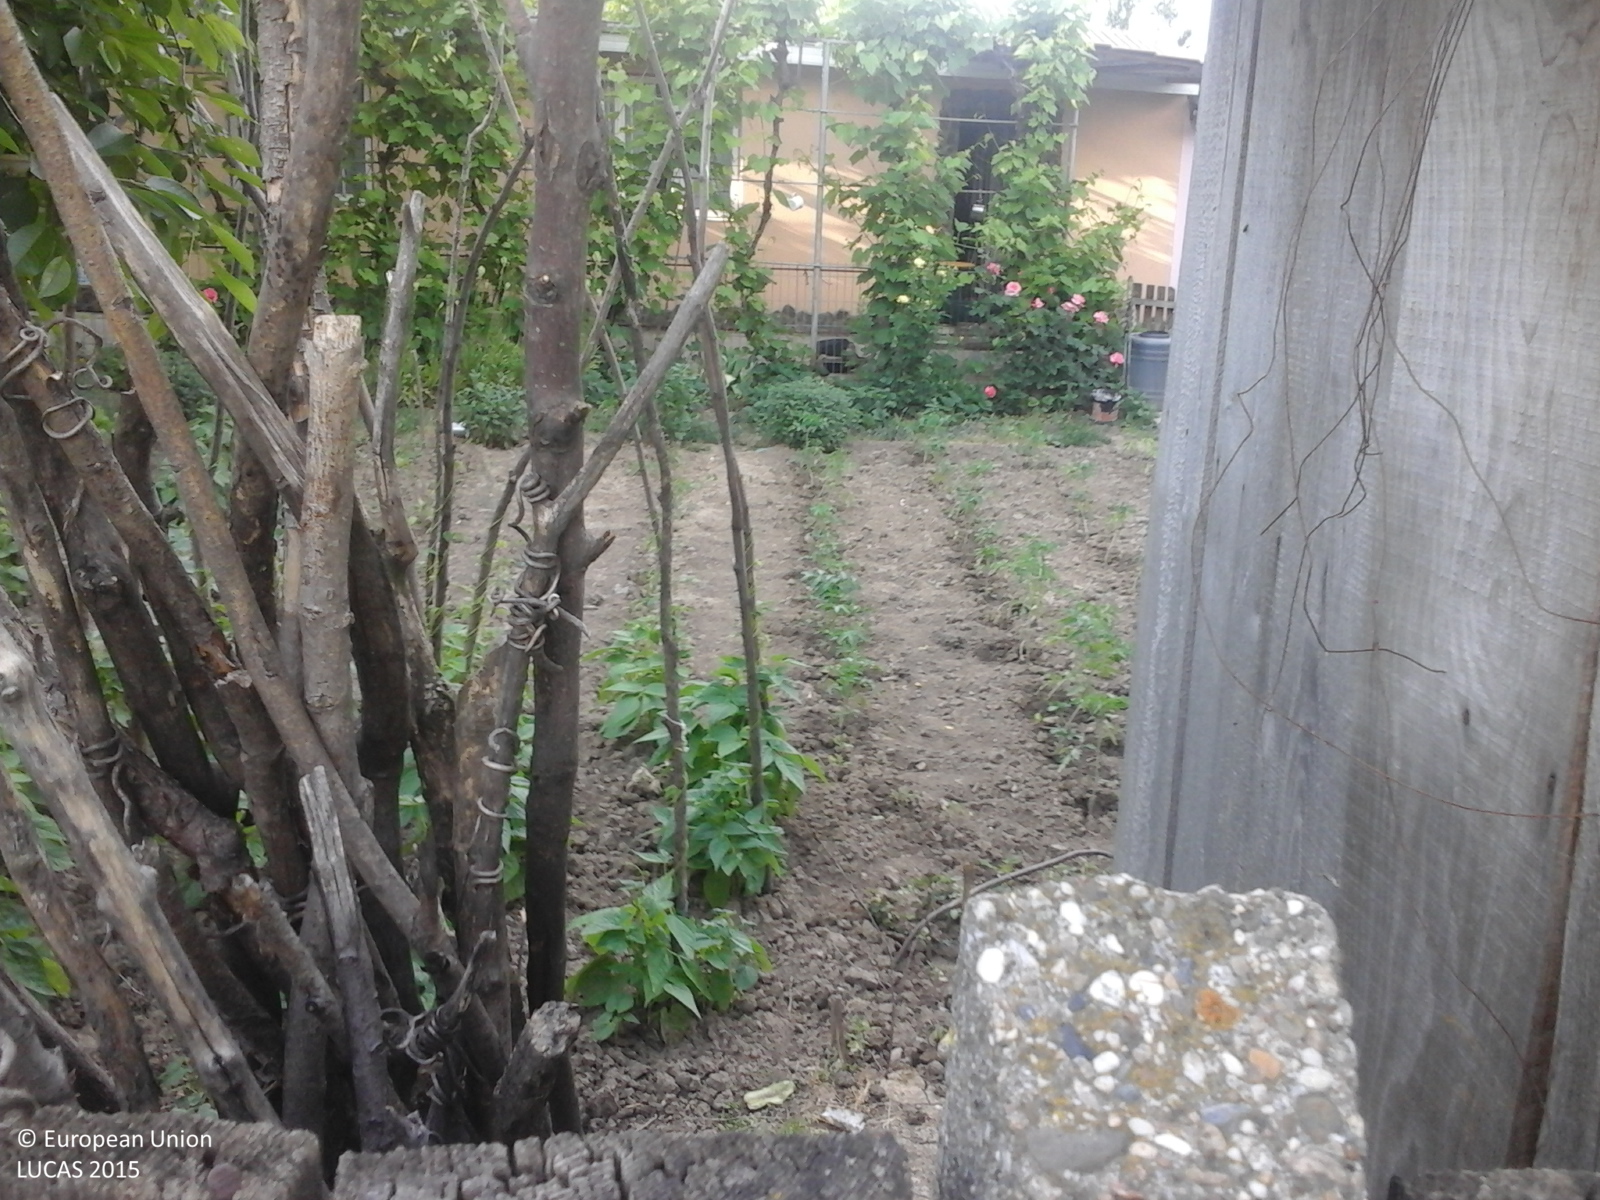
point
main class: Cropland
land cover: Other fresh vegetables
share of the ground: < 10 %
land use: Kitchen garden
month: June
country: RO
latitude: 46.4292
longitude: 26.8926
